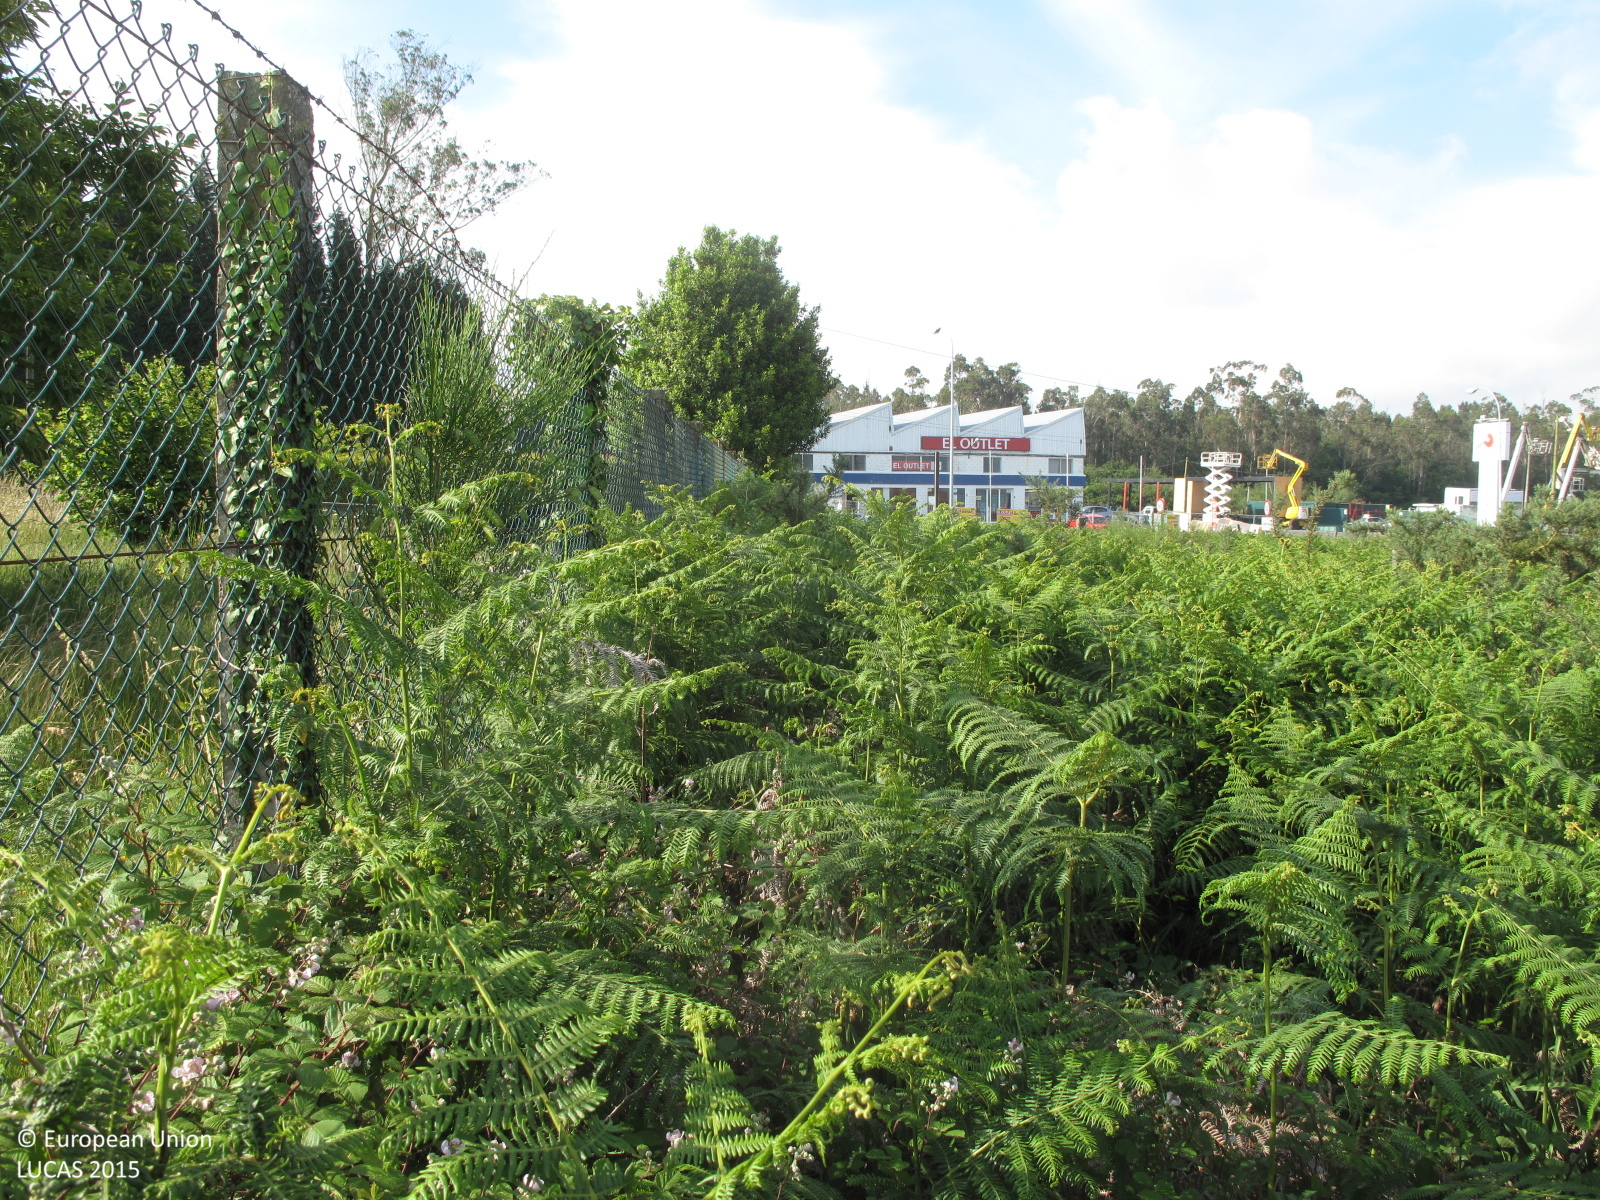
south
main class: Woodland
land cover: Broadleaved woodland
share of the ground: 10 - 25 %
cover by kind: herbaceous plants 85 %, broadleaved forest trees 15 %
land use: Residential
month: June
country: ES
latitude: 42.8937
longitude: -8.4838
